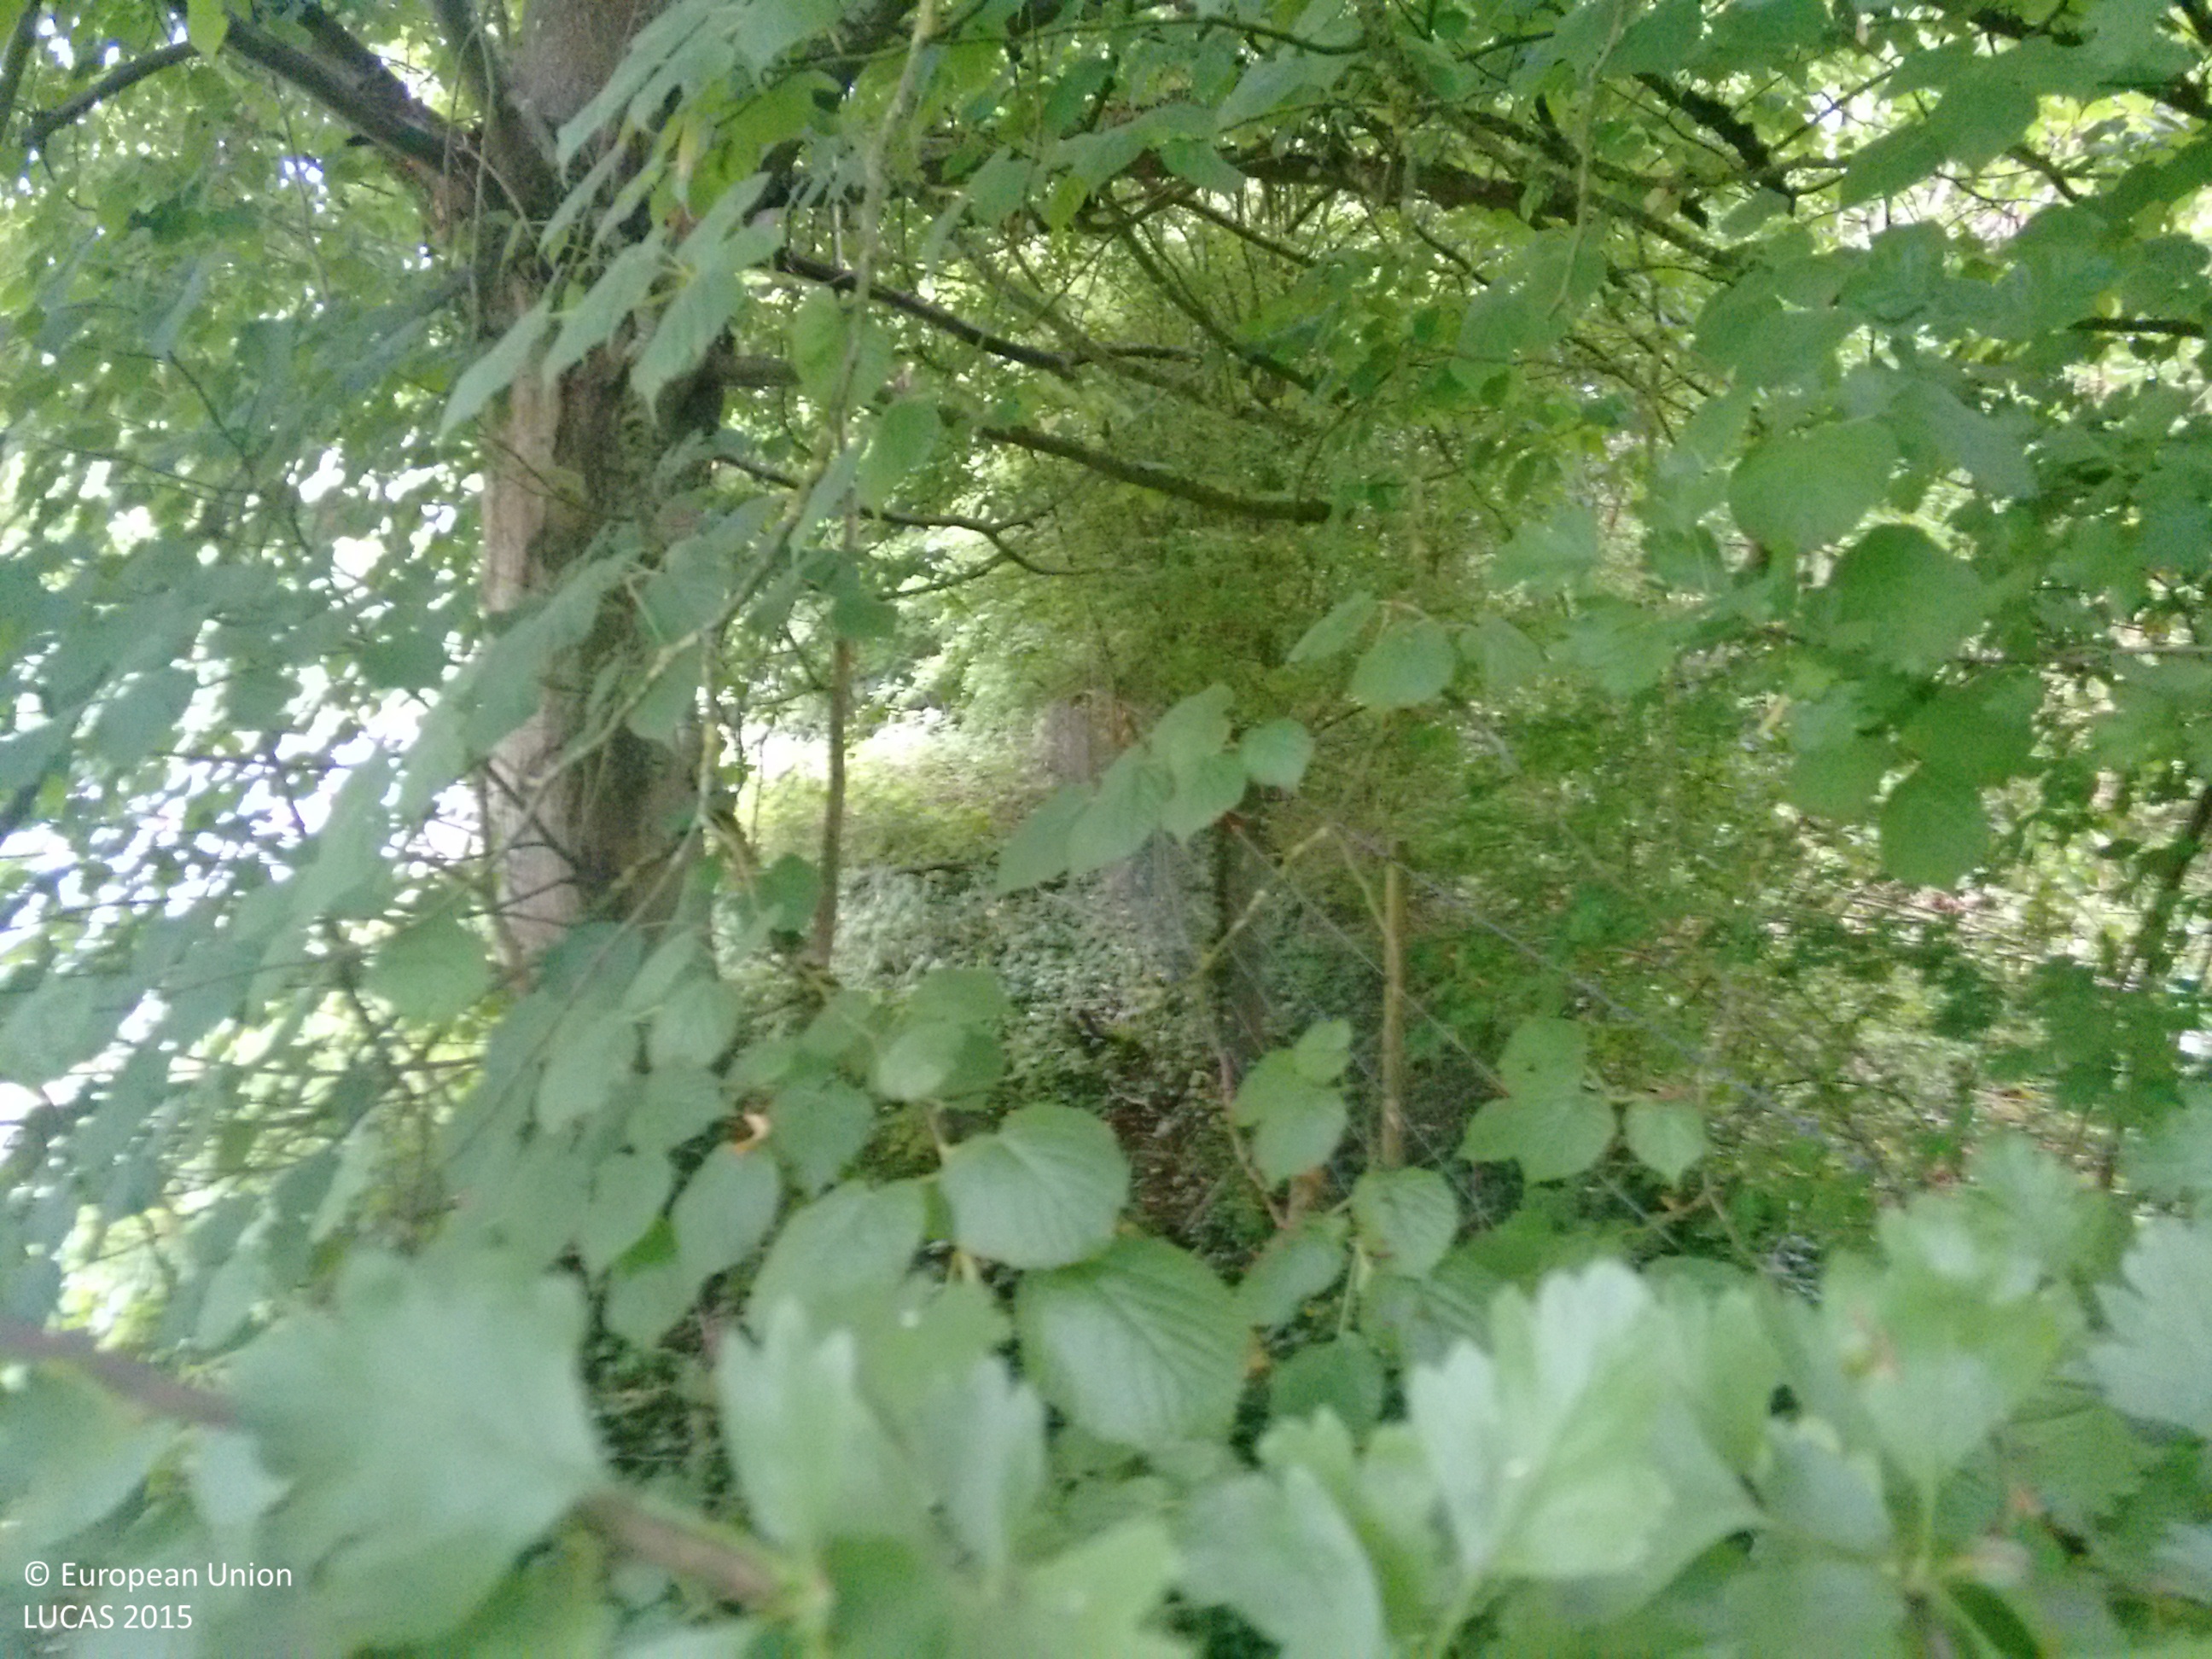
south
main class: Woodland
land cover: Broadleaved woodland
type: mesophytic deciduous forest
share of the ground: > 75 %
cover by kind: broadleaved forest trees 100 %
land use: Forestry
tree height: > 5 m
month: July
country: GB
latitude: 51.0002
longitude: -1.1180
